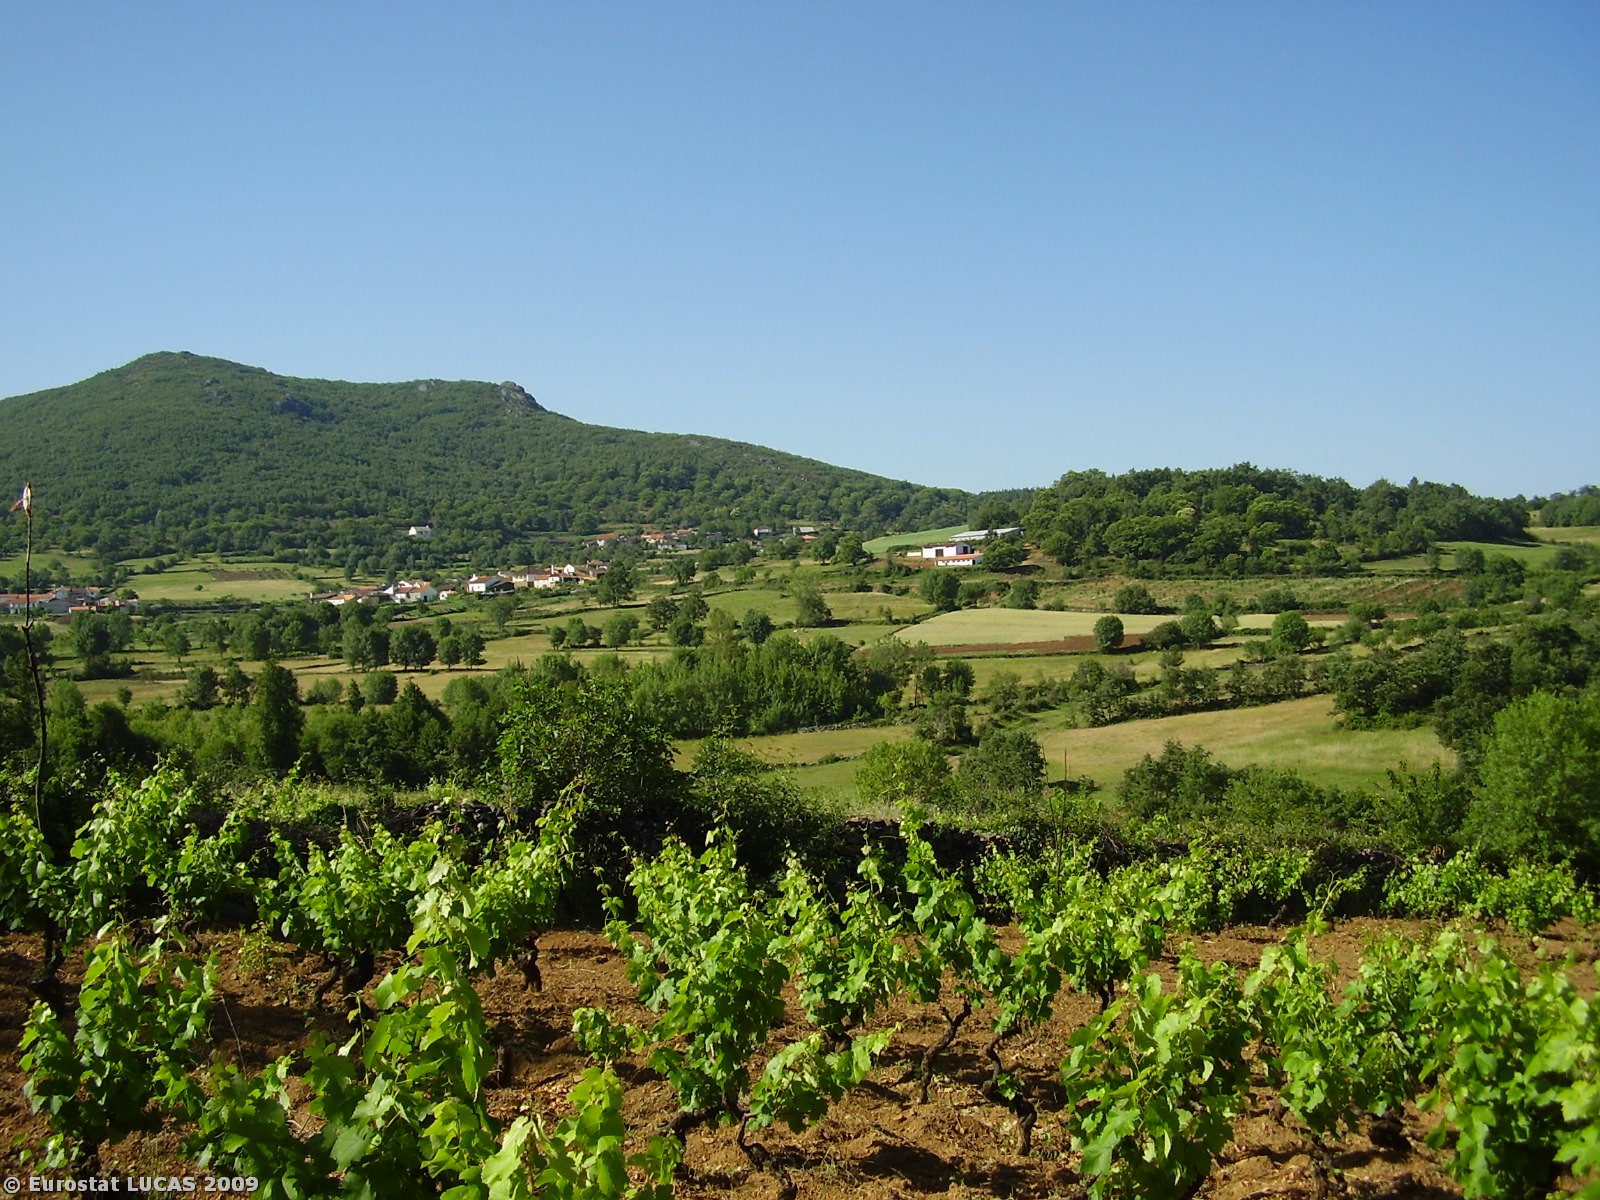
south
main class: Cropland
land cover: Vineyards
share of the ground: 25 - 50 %
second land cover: Bare land
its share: 10 - 25 %
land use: Agriculture (excluding fallow land and kitchen gardens)
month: June
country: PT
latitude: 41.8015
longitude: -6.9555
